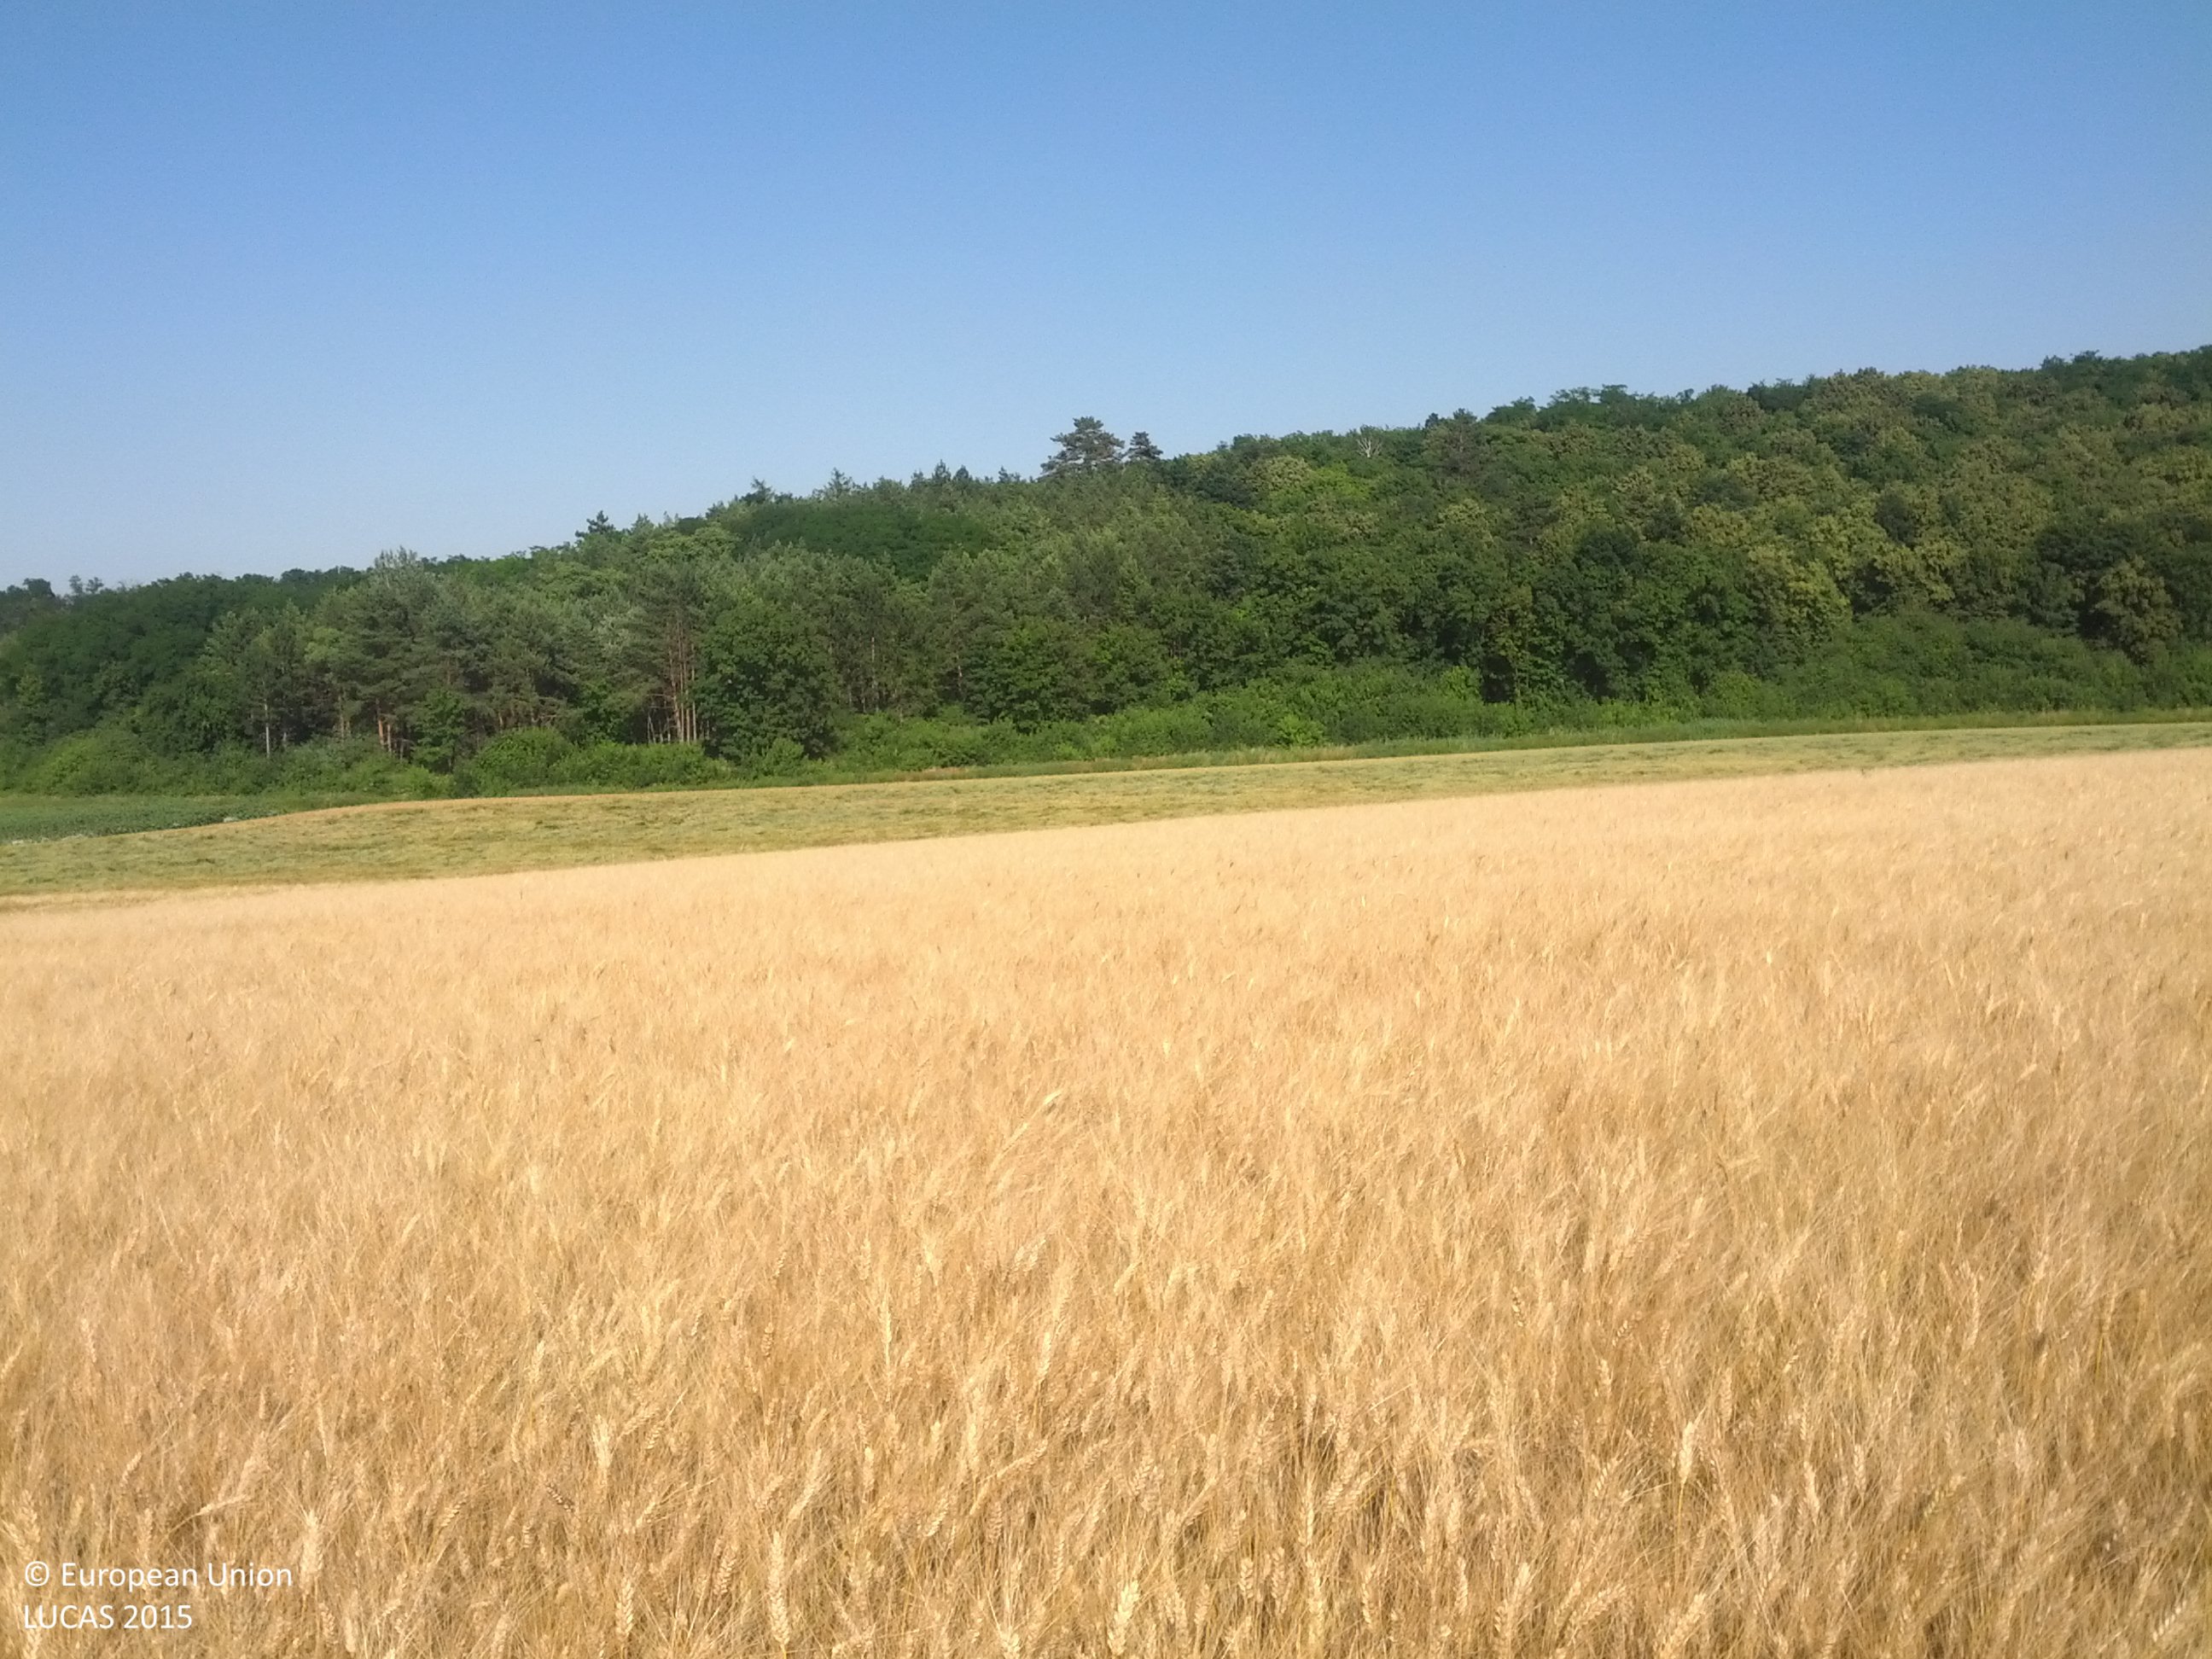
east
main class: Cropland
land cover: Barley
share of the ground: > 75 %
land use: Agriculture (excluding fallow land and kitchen gardens)
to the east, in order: Barley; Grass margins; Ditches and canals; Shrubland without tree cover; Other mixed woodland
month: July
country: AT
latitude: 48.5474
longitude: 16.6308
